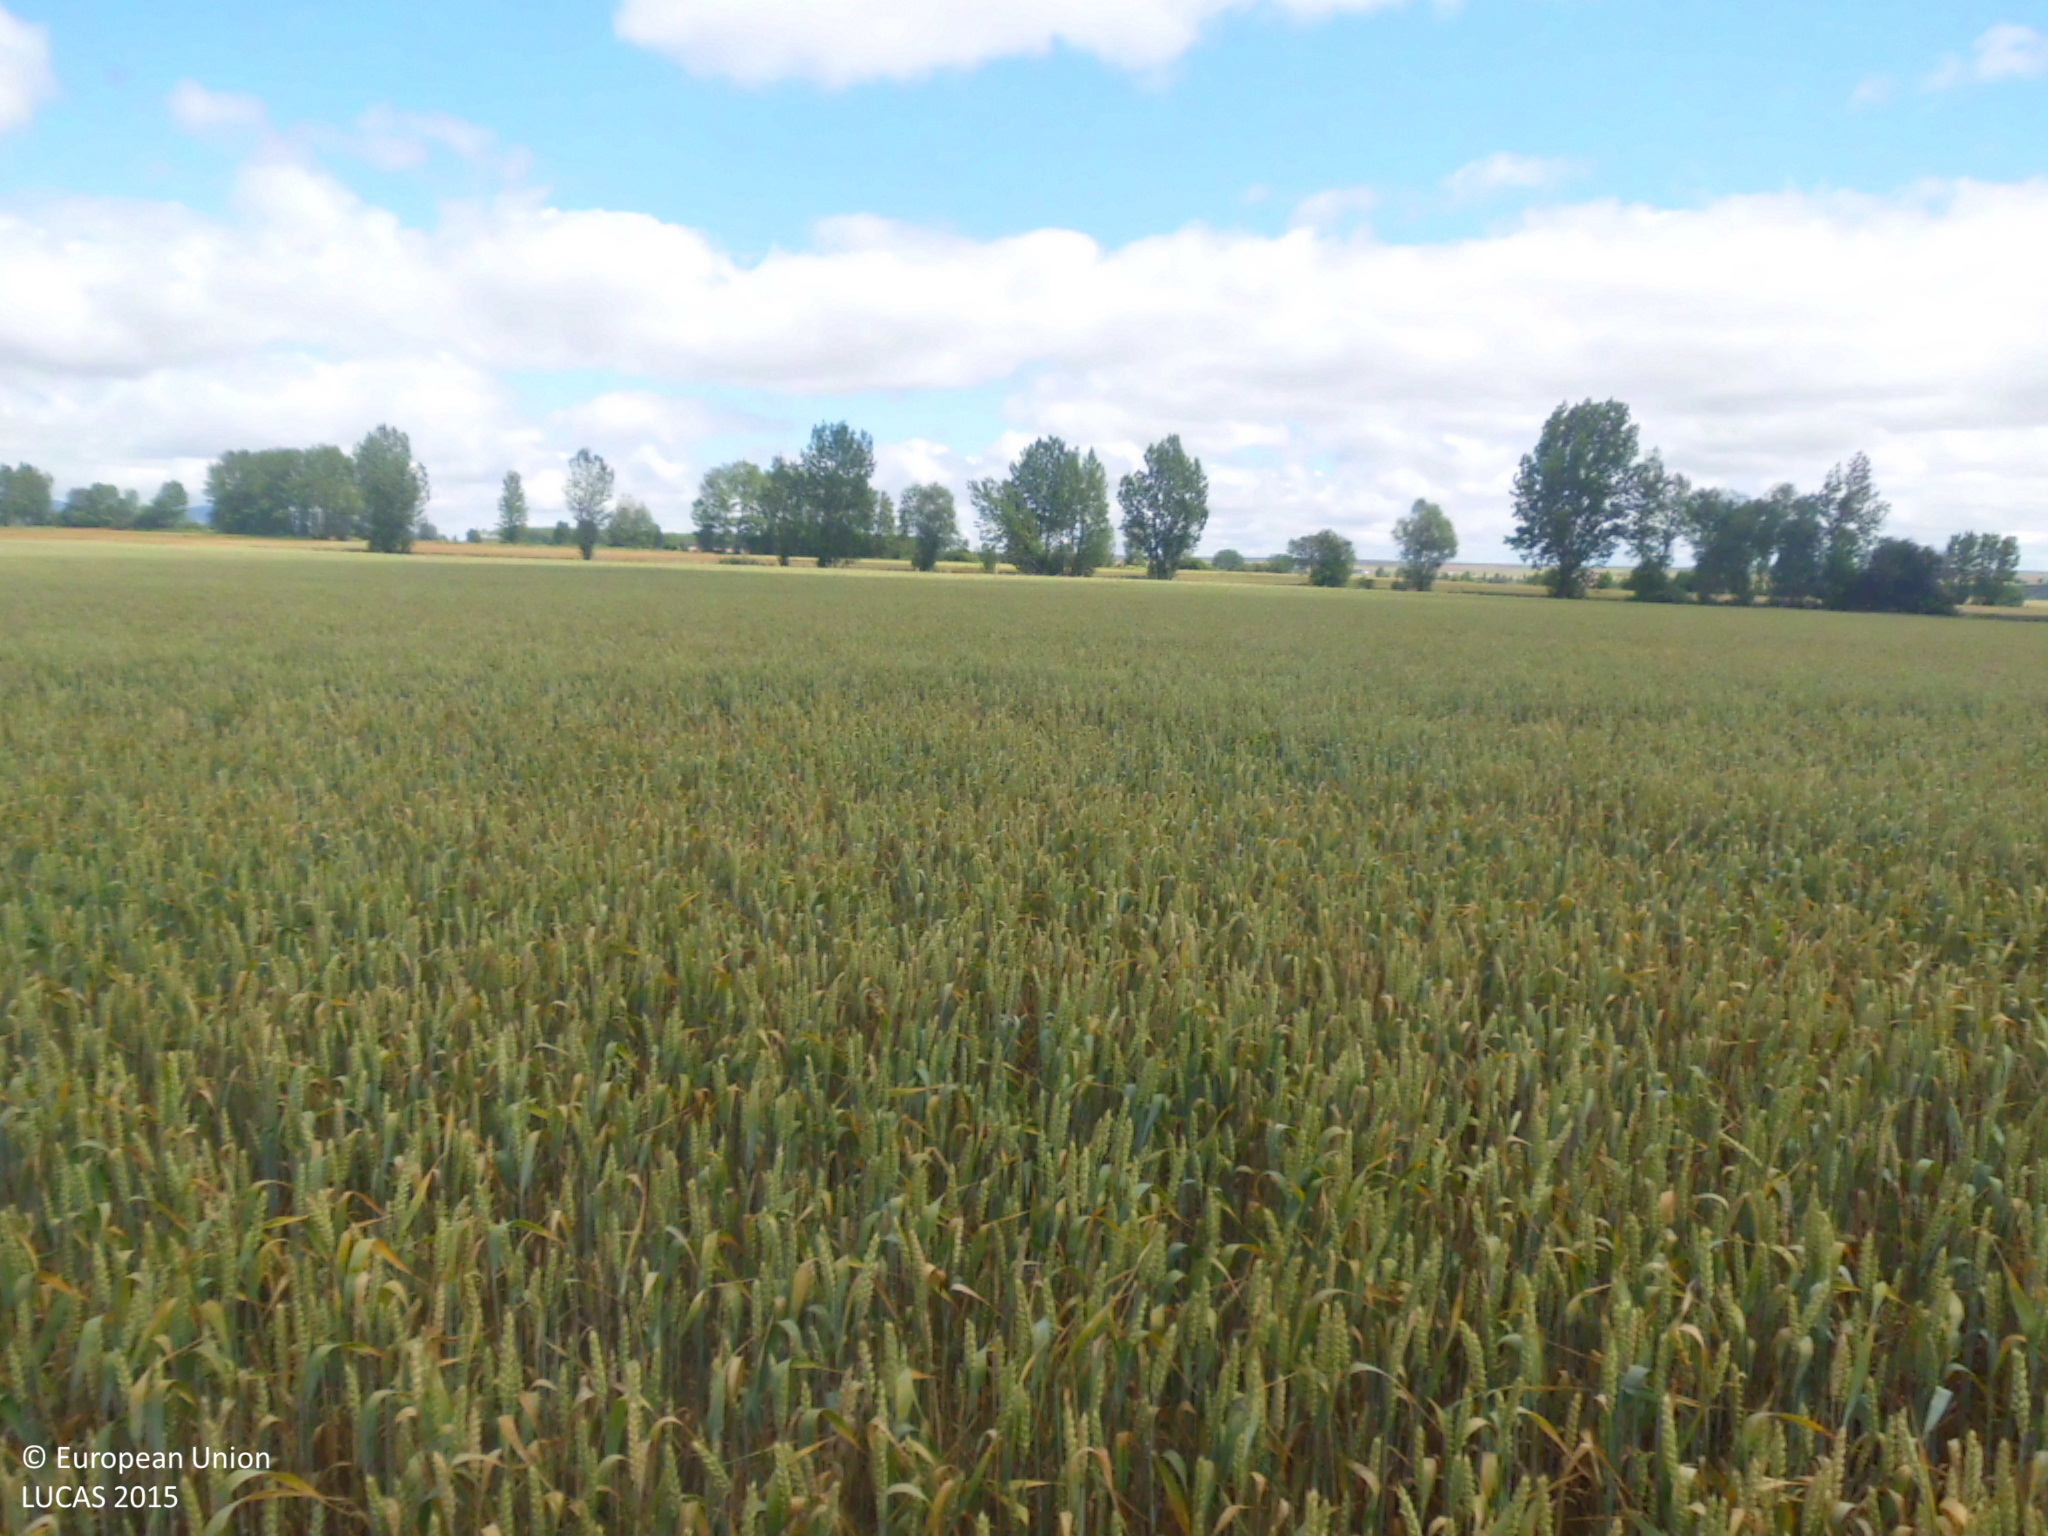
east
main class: Cropland
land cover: Common wheat
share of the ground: > 75 %
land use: Agriculture (excluding fallow land and kitchen gardens)
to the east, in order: Common wheat; Rivers and streams; Common wheat; Rivers and streams; Barley; Spontaneously vegetated surfaces
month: June
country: ES
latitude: 42.6508
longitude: -3.2925
